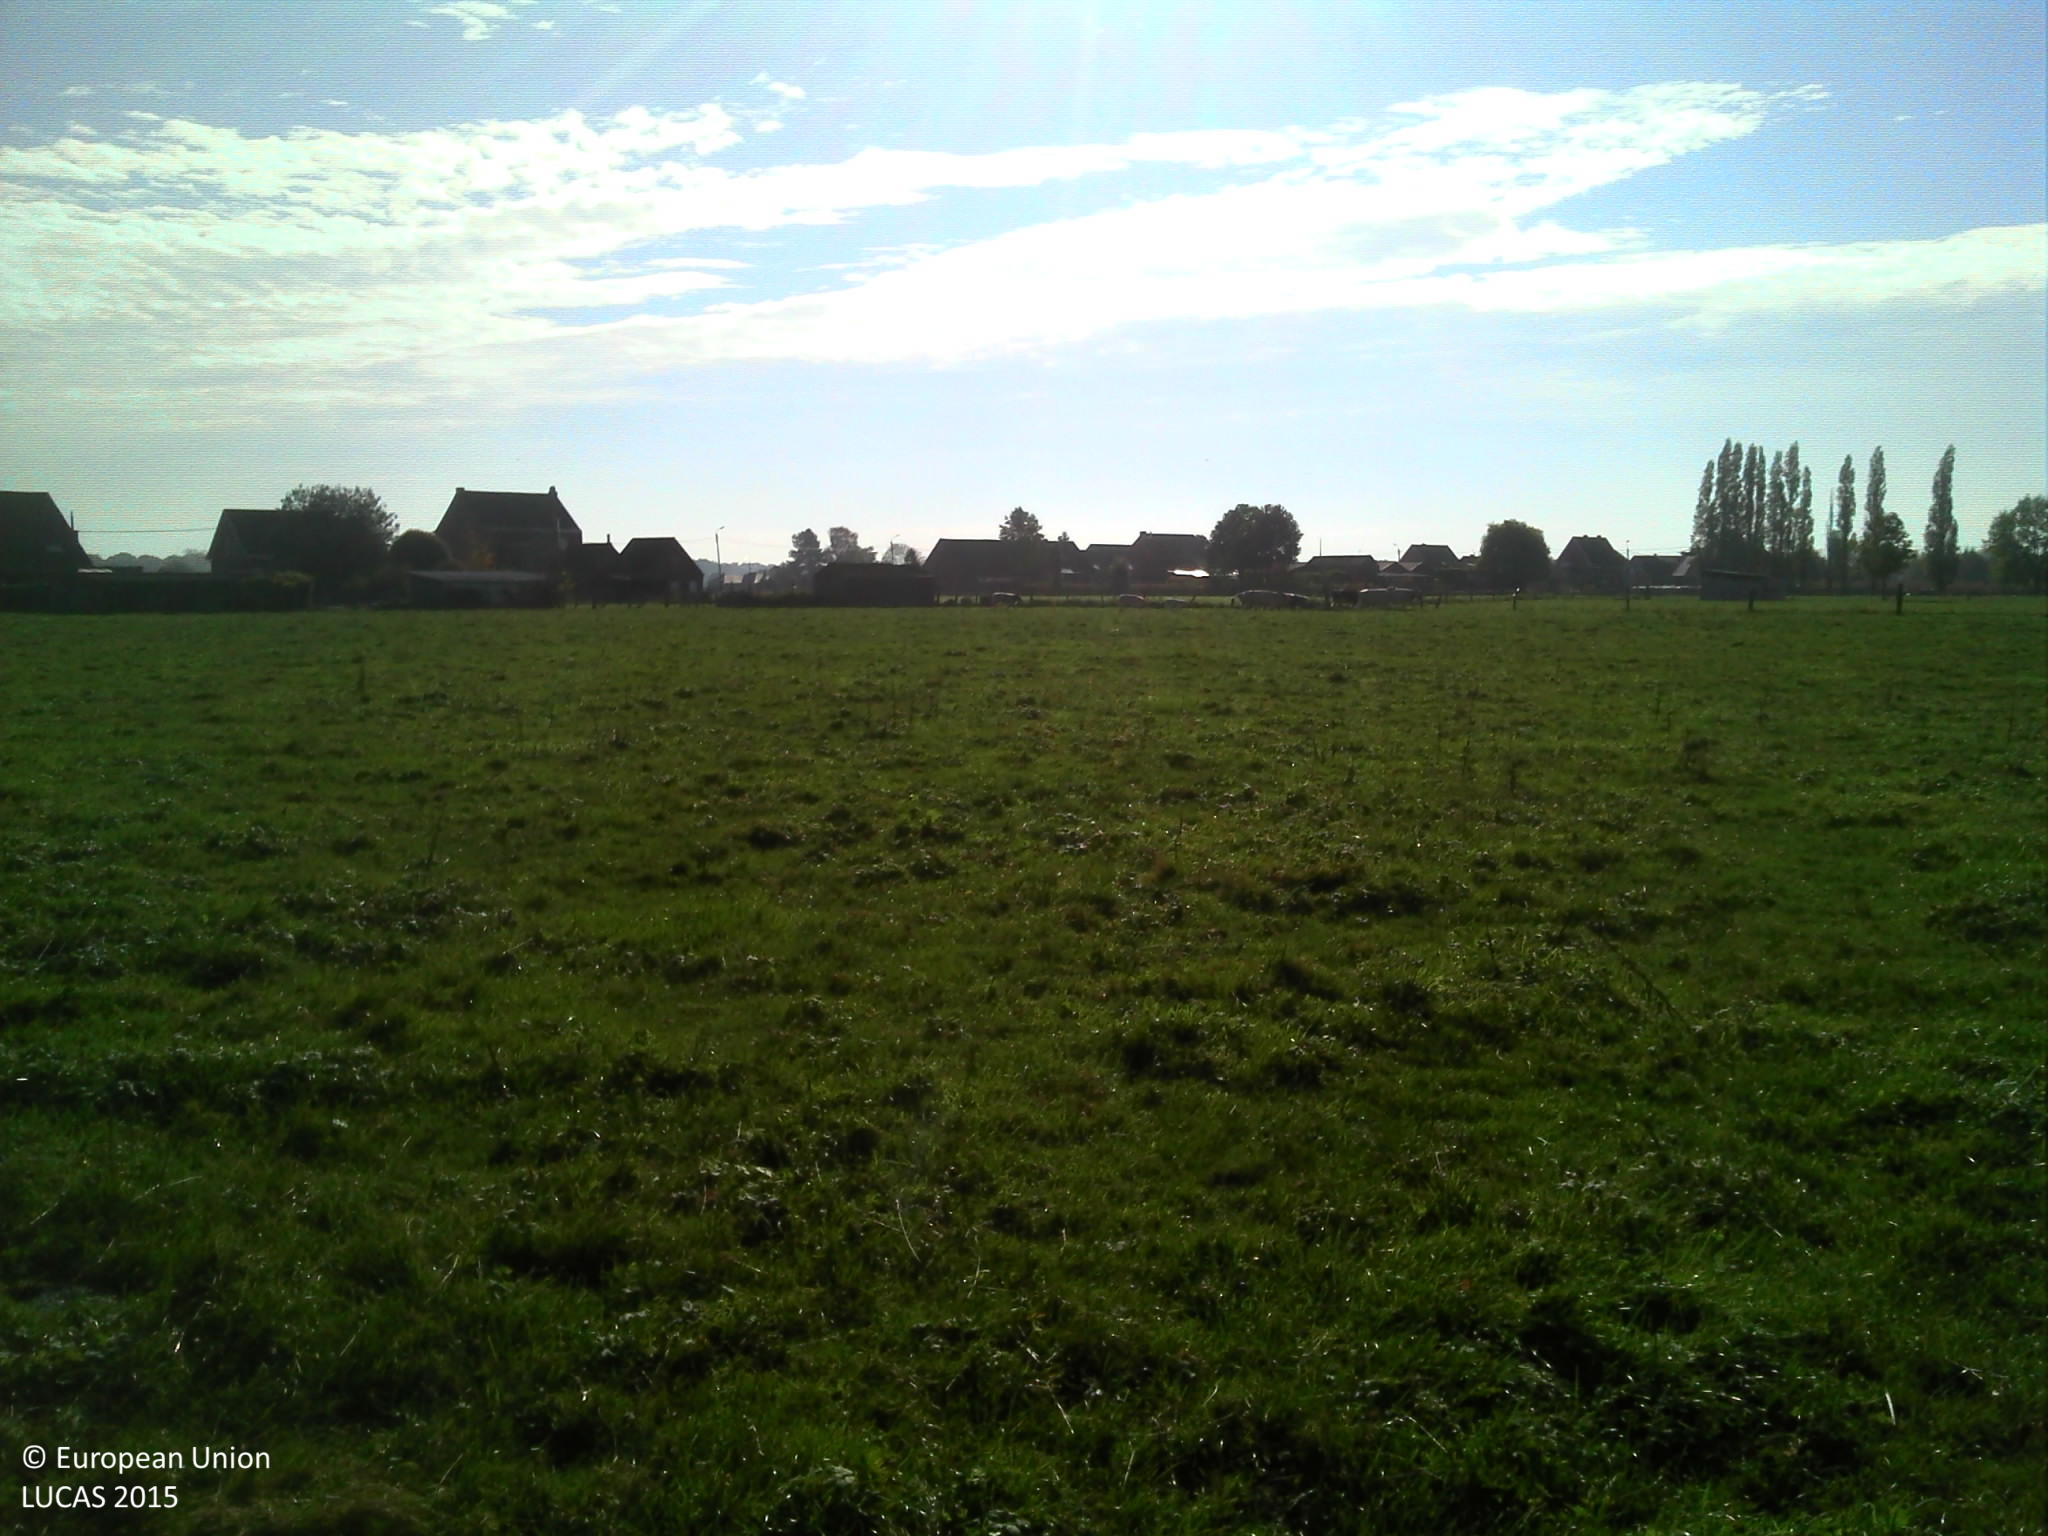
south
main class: Grassland
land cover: Grassland without tree/shrub cover
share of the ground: > 75 %
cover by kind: herbaceous plants 100 %
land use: Agriculture (excluding fallow land and kitchen gardens)
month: October
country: BE
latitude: 51.0003
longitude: 4.3667
